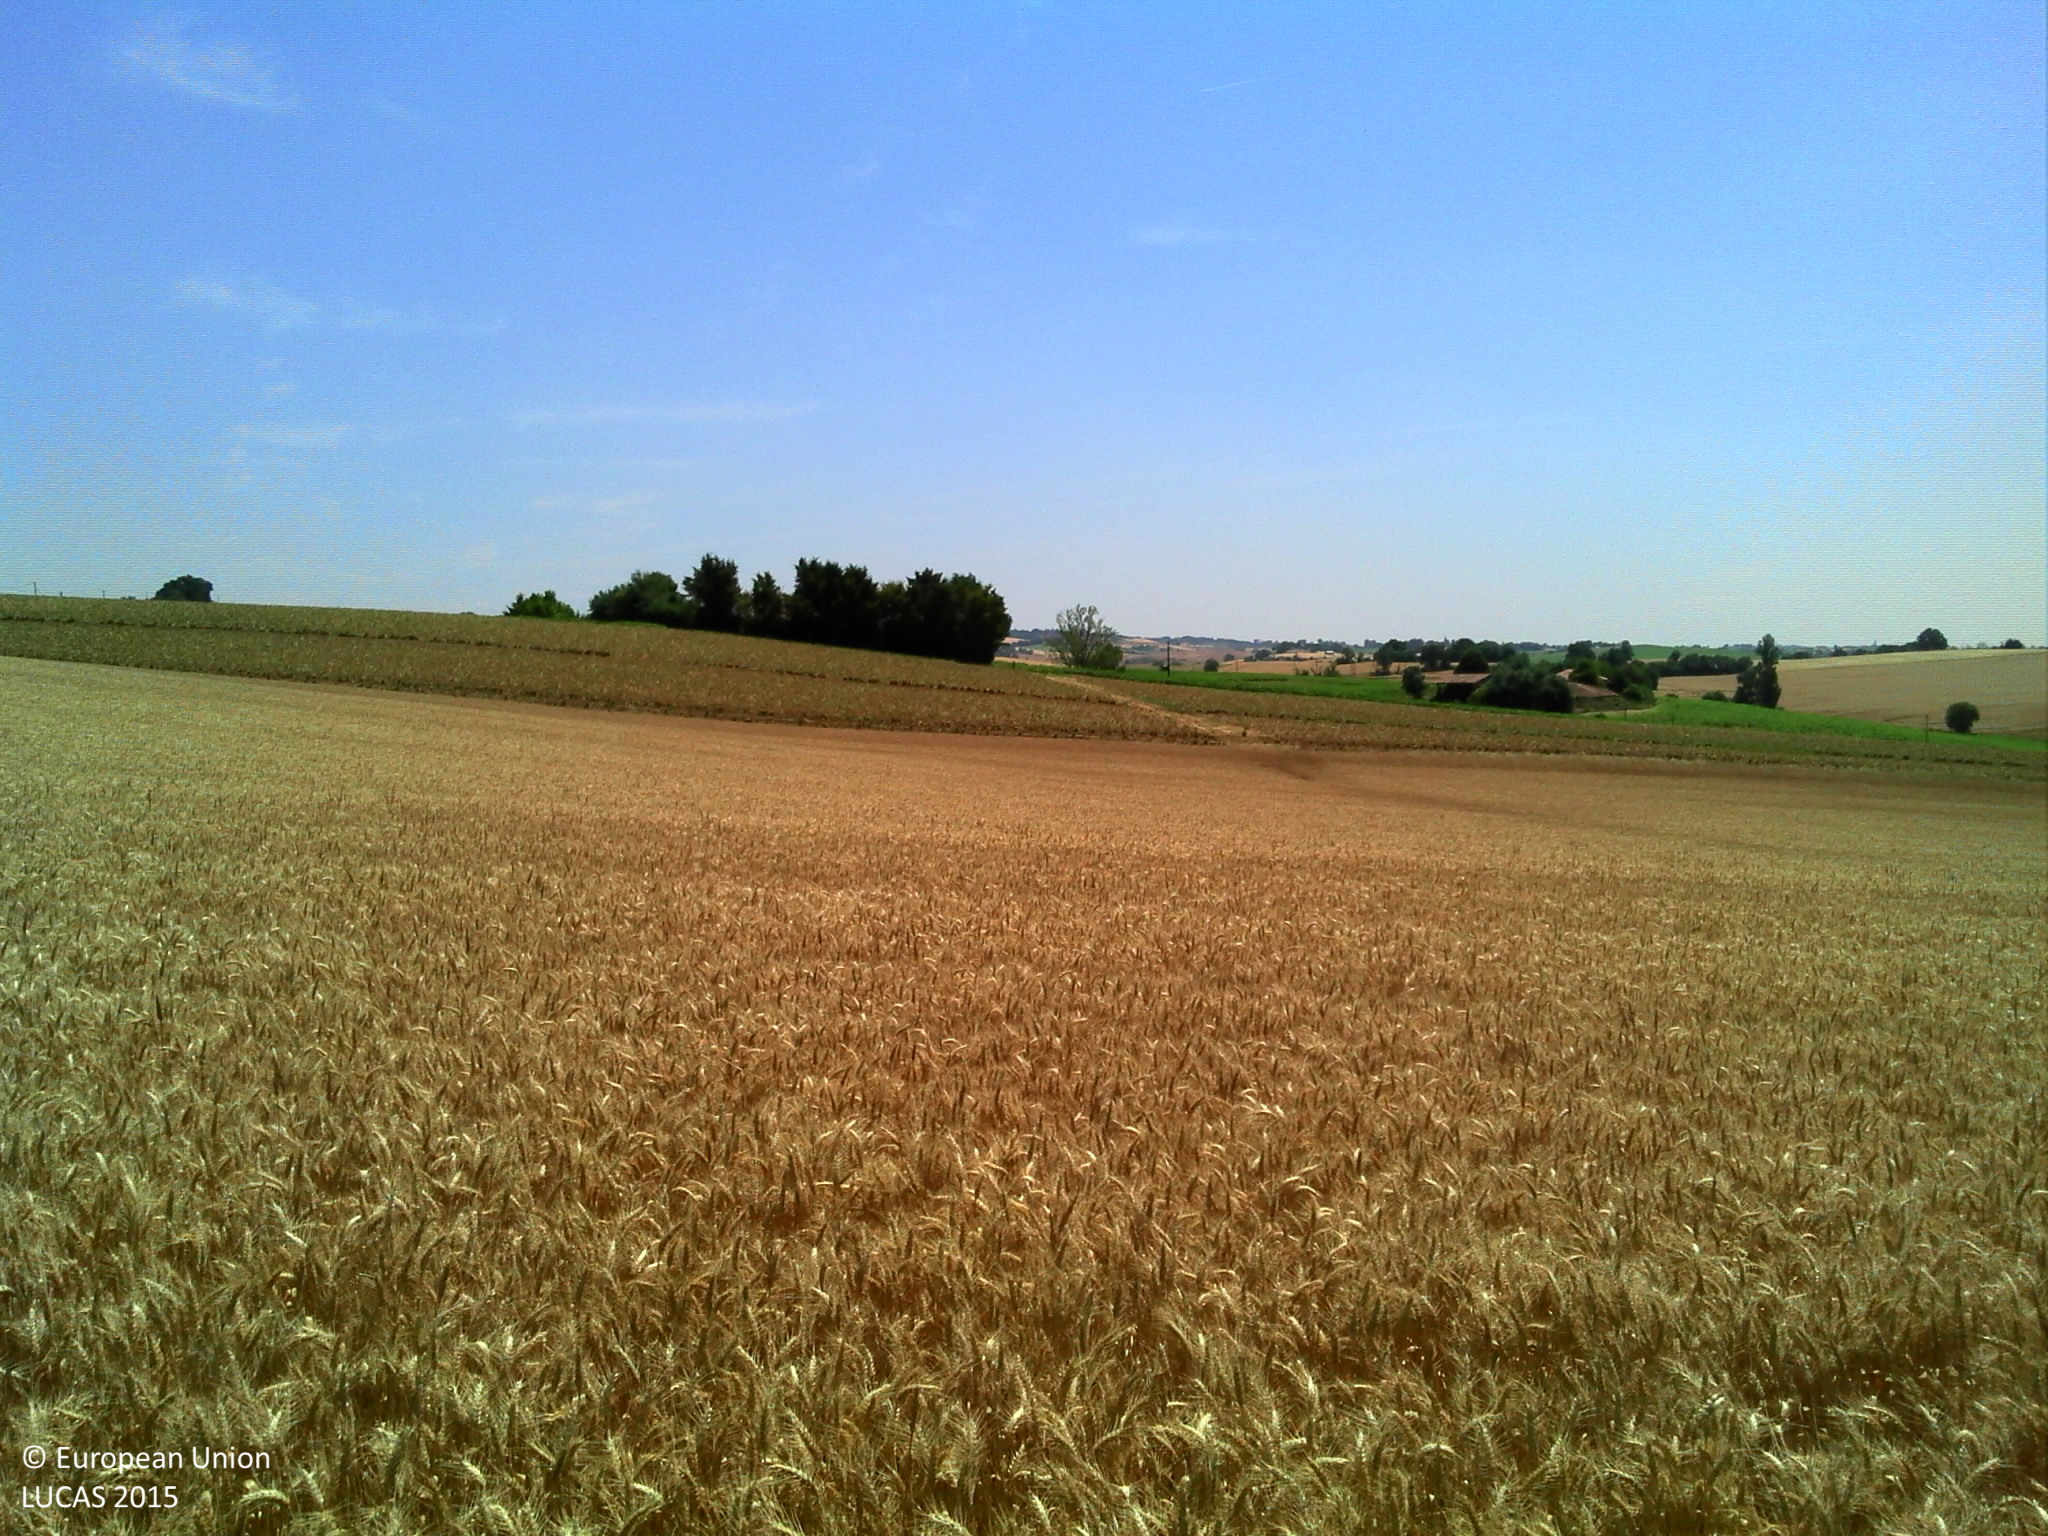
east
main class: Cropland
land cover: Common wheat
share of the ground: > 75 %
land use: Agriculture (excluding fallow land and kitchen gardens)
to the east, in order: Common wheat; Other root crops; Sunflower
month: June
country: FR
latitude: 43.7745
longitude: 0.9670
